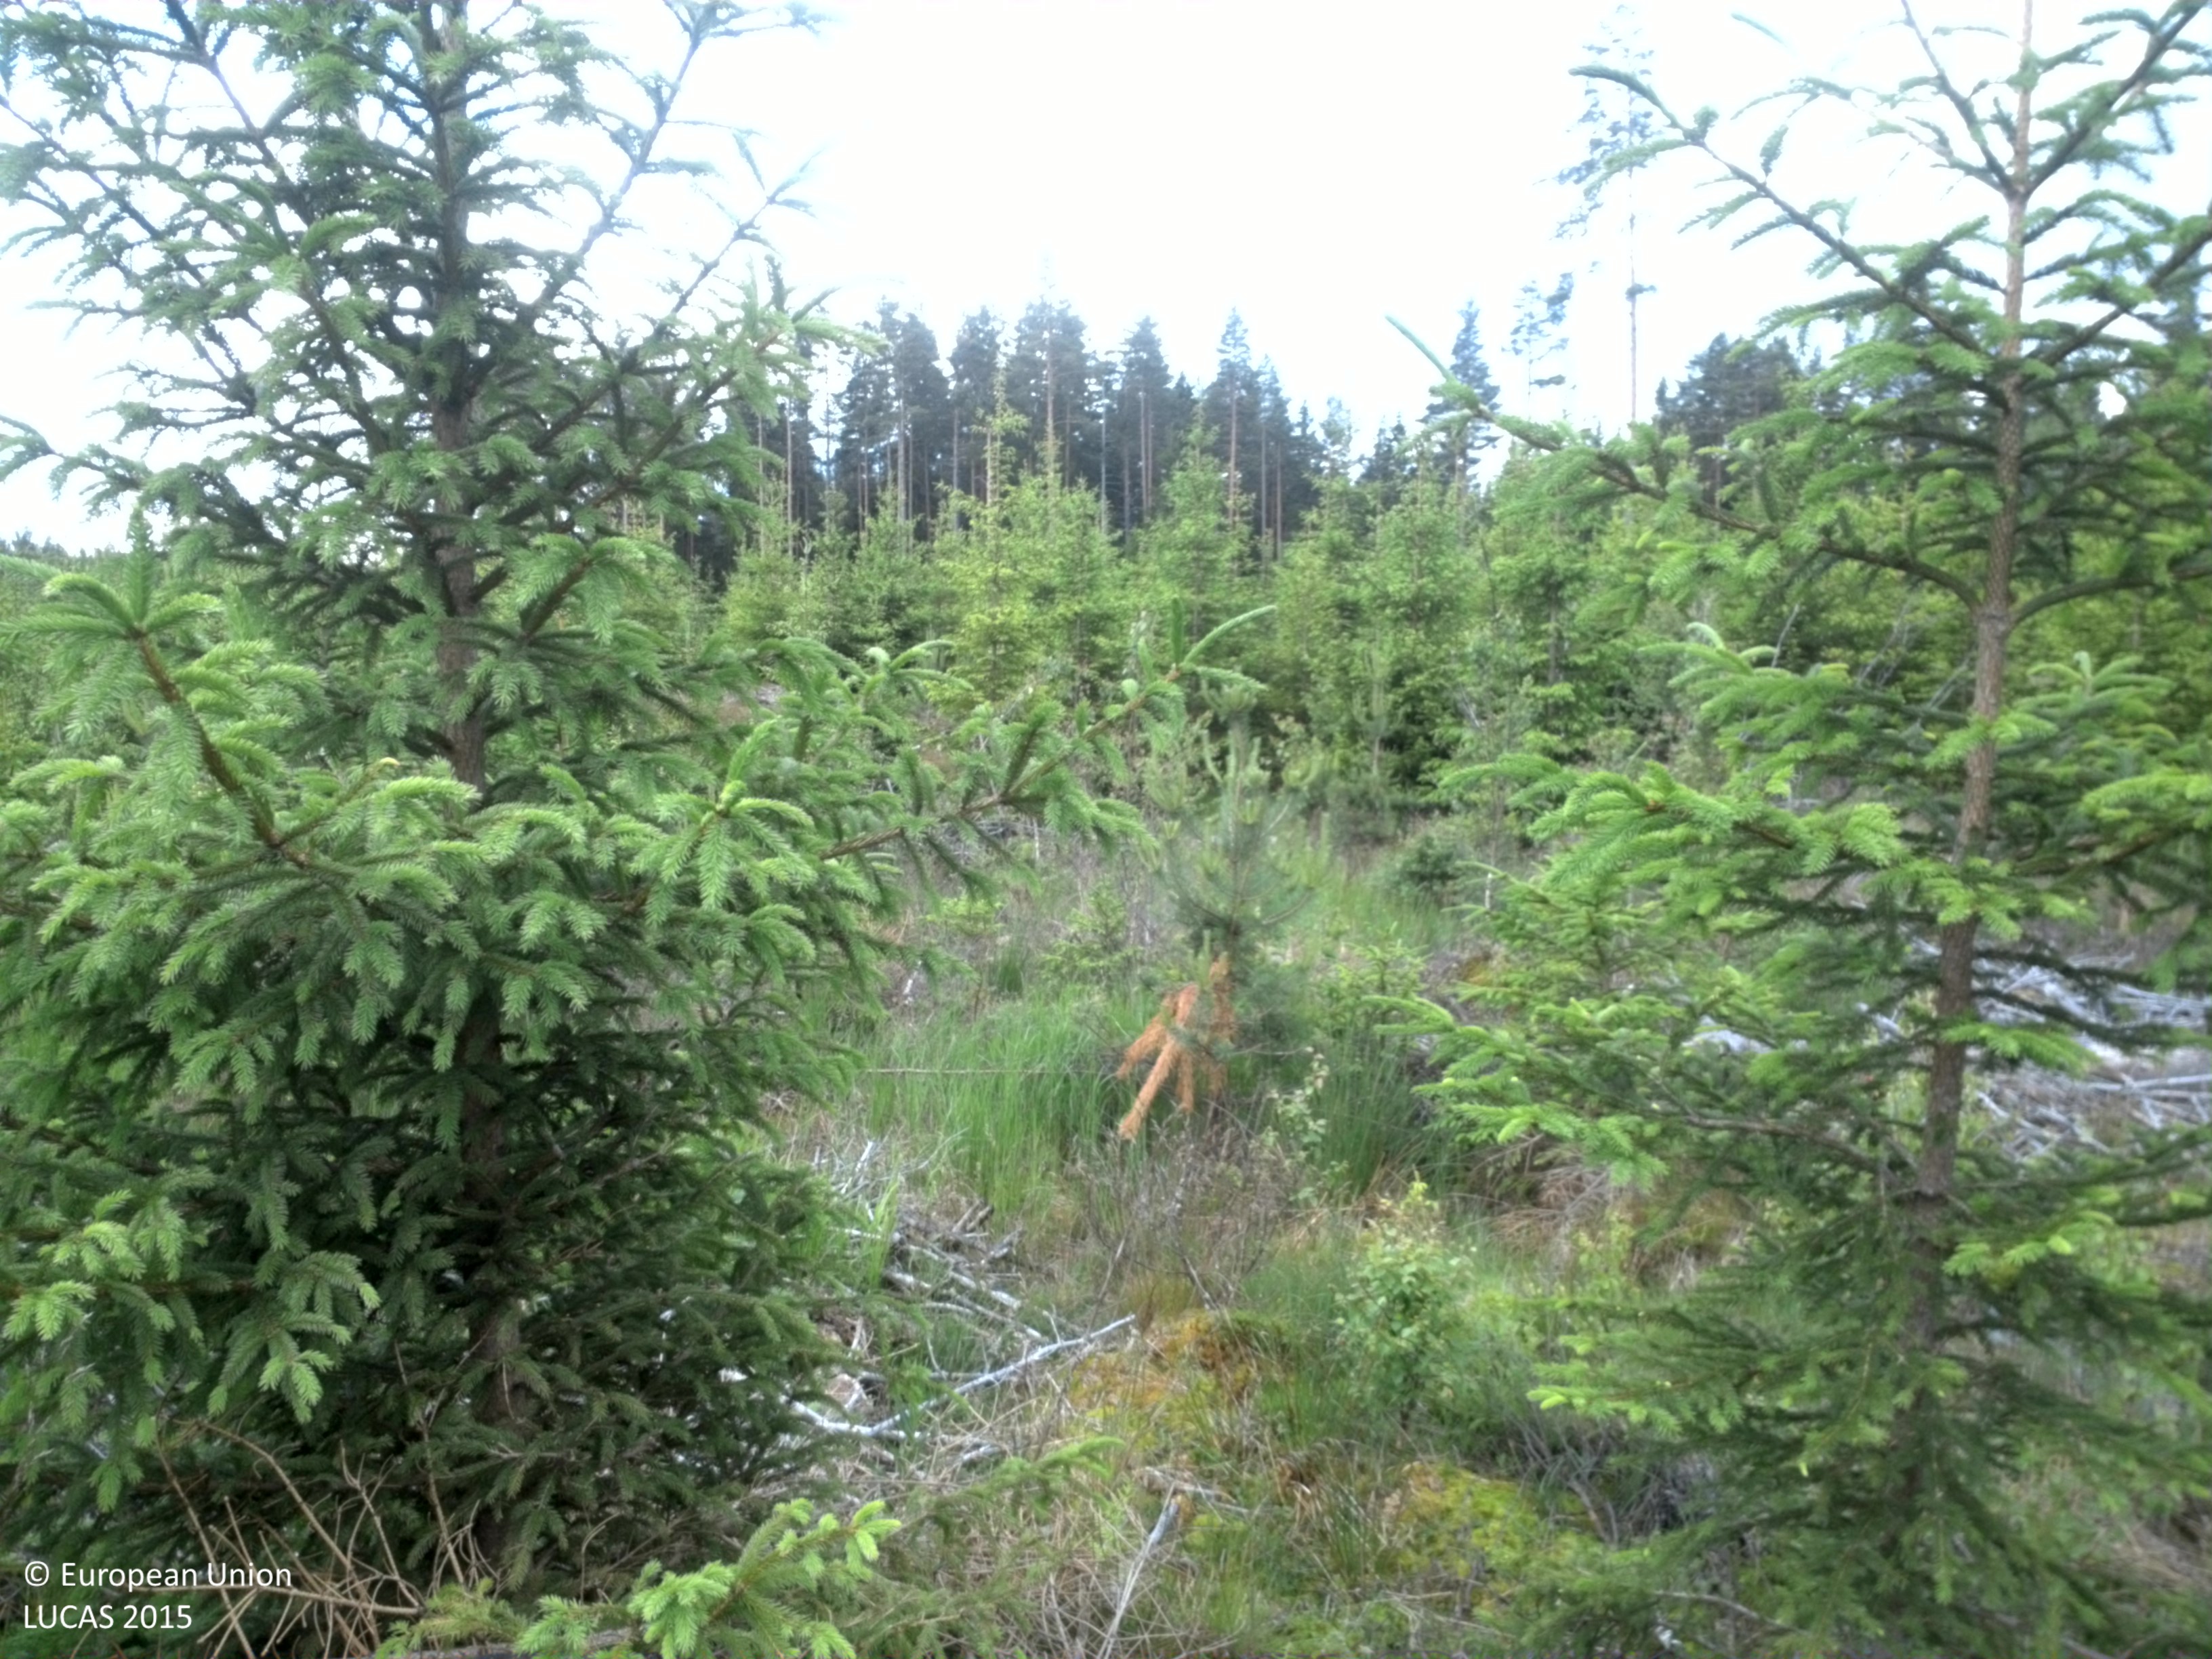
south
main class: Woodland
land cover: Spruce dominated coniferous woodland
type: boreal forest
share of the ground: 50 - 75 %
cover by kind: coniferous forest trees 60 %, herbaceous plants 30 %, broadleaved forest trees 5 %, lichens and mosses 5 %
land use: Forestry
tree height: < 5 m
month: June
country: SE
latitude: 58.6356
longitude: 15.7993
